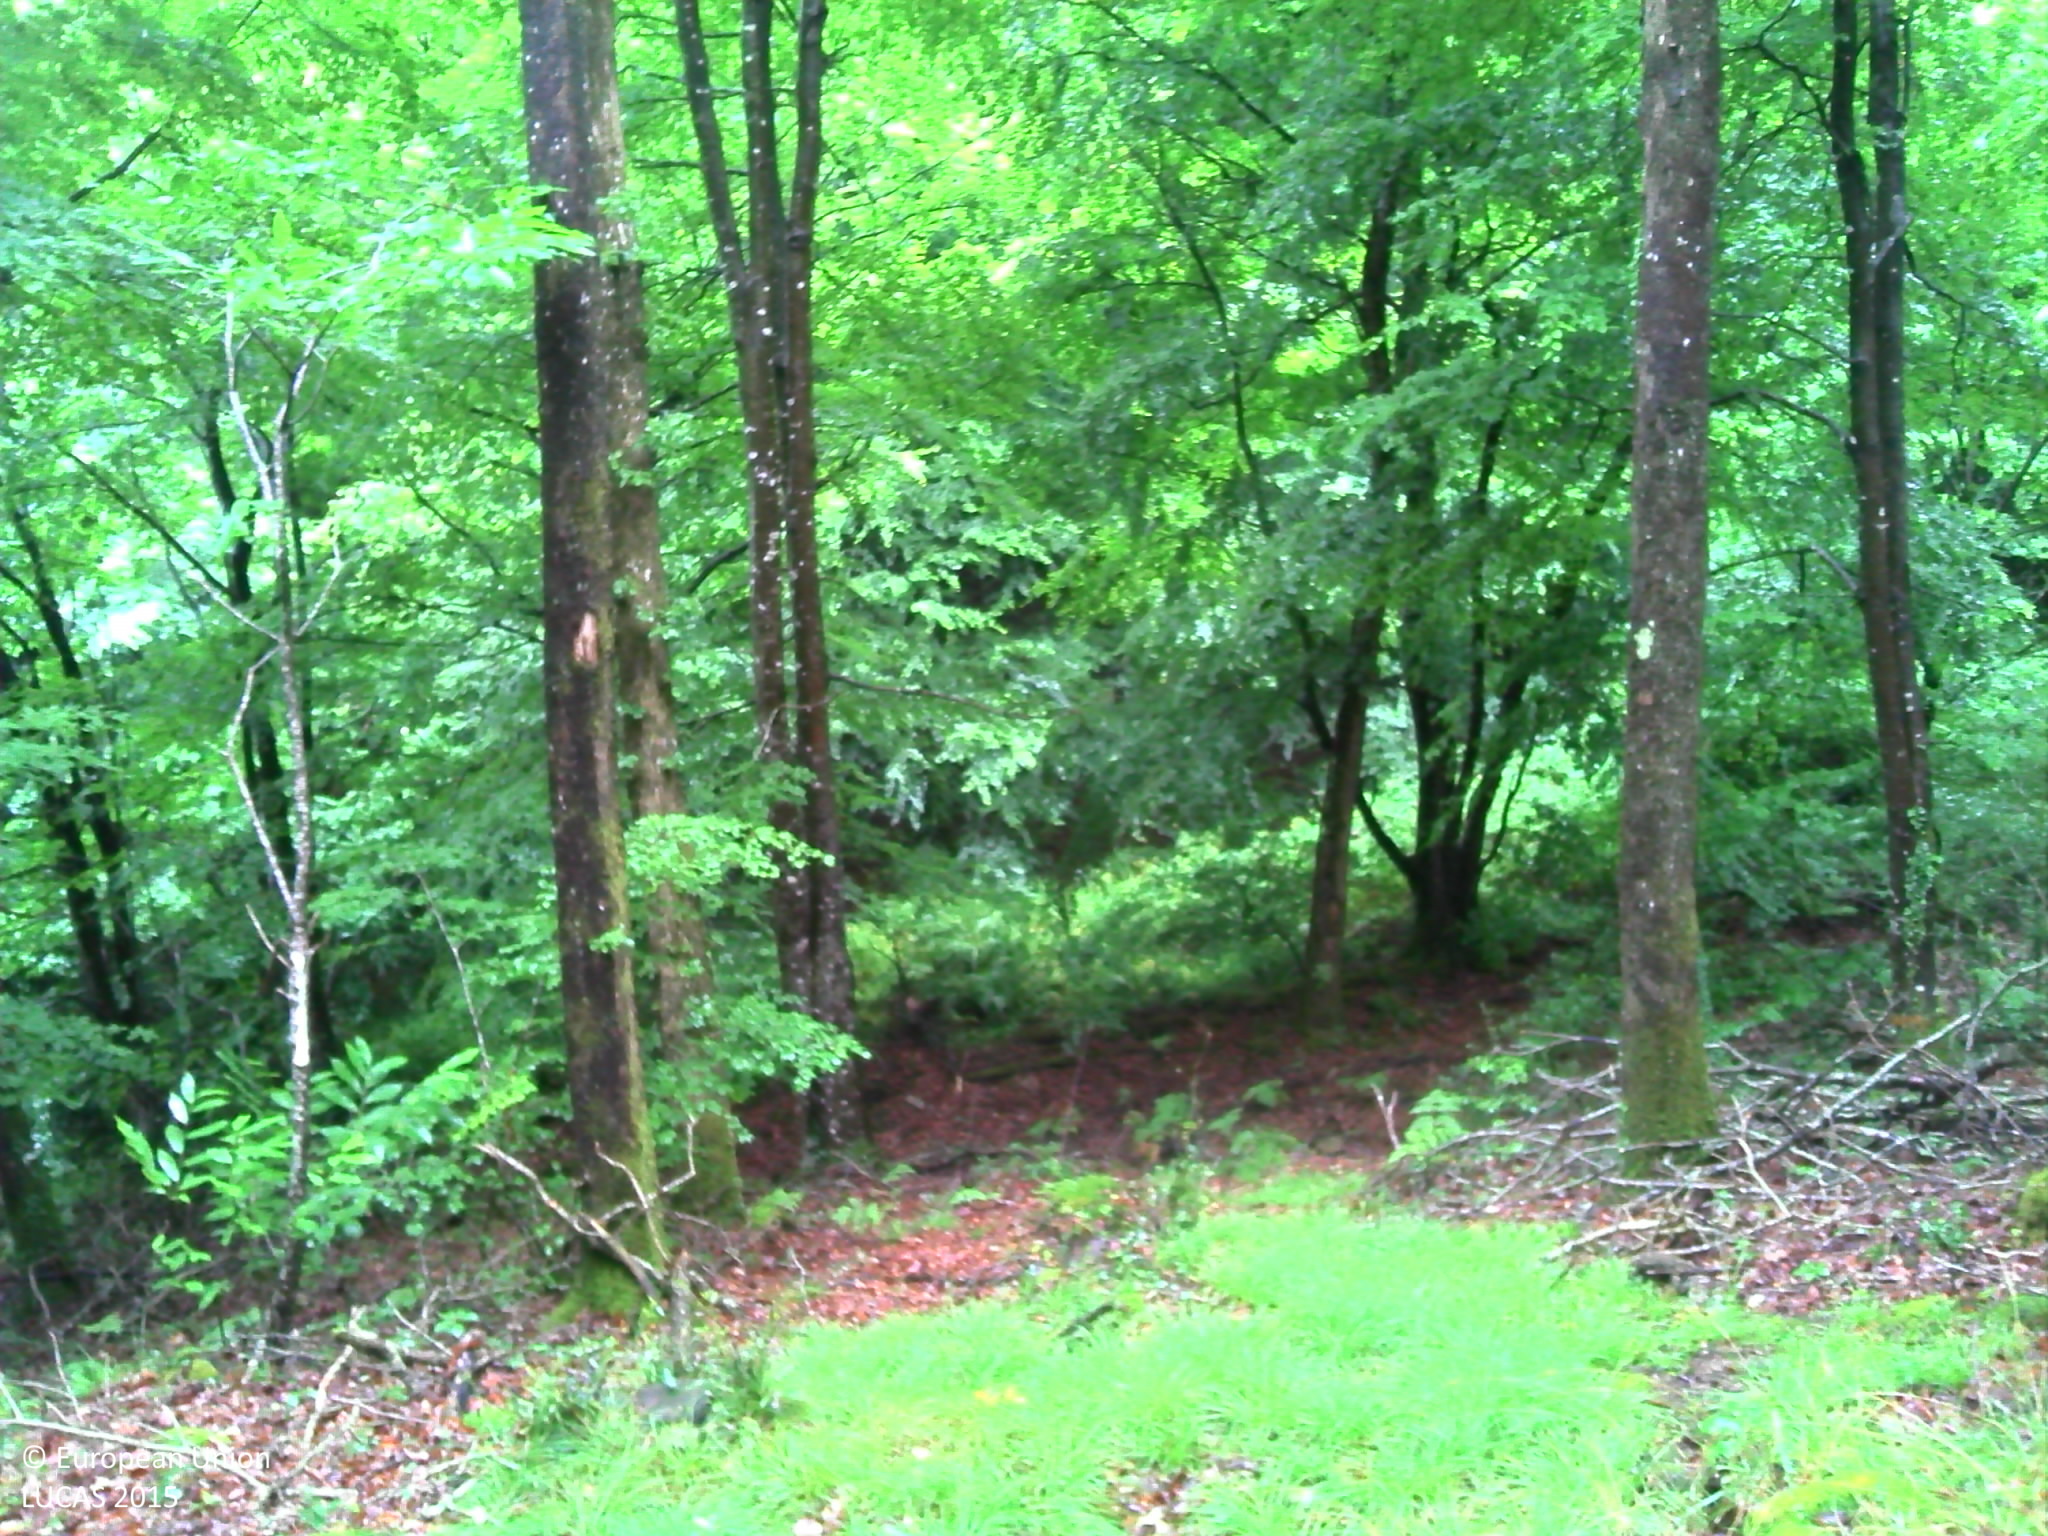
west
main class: Woodland
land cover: Broadleaved woodland
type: acidophilous oak and oak-birch forest
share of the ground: > 75 %
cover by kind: broadleaved forest trees 70 %, lichens and mosses 10 %, consolidated bare surface 10 %, shrubs 5 %, herbaceous plants 5 %
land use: Forestry
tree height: > 5 m
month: July
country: FR
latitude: 47.8051
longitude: -2.9239
